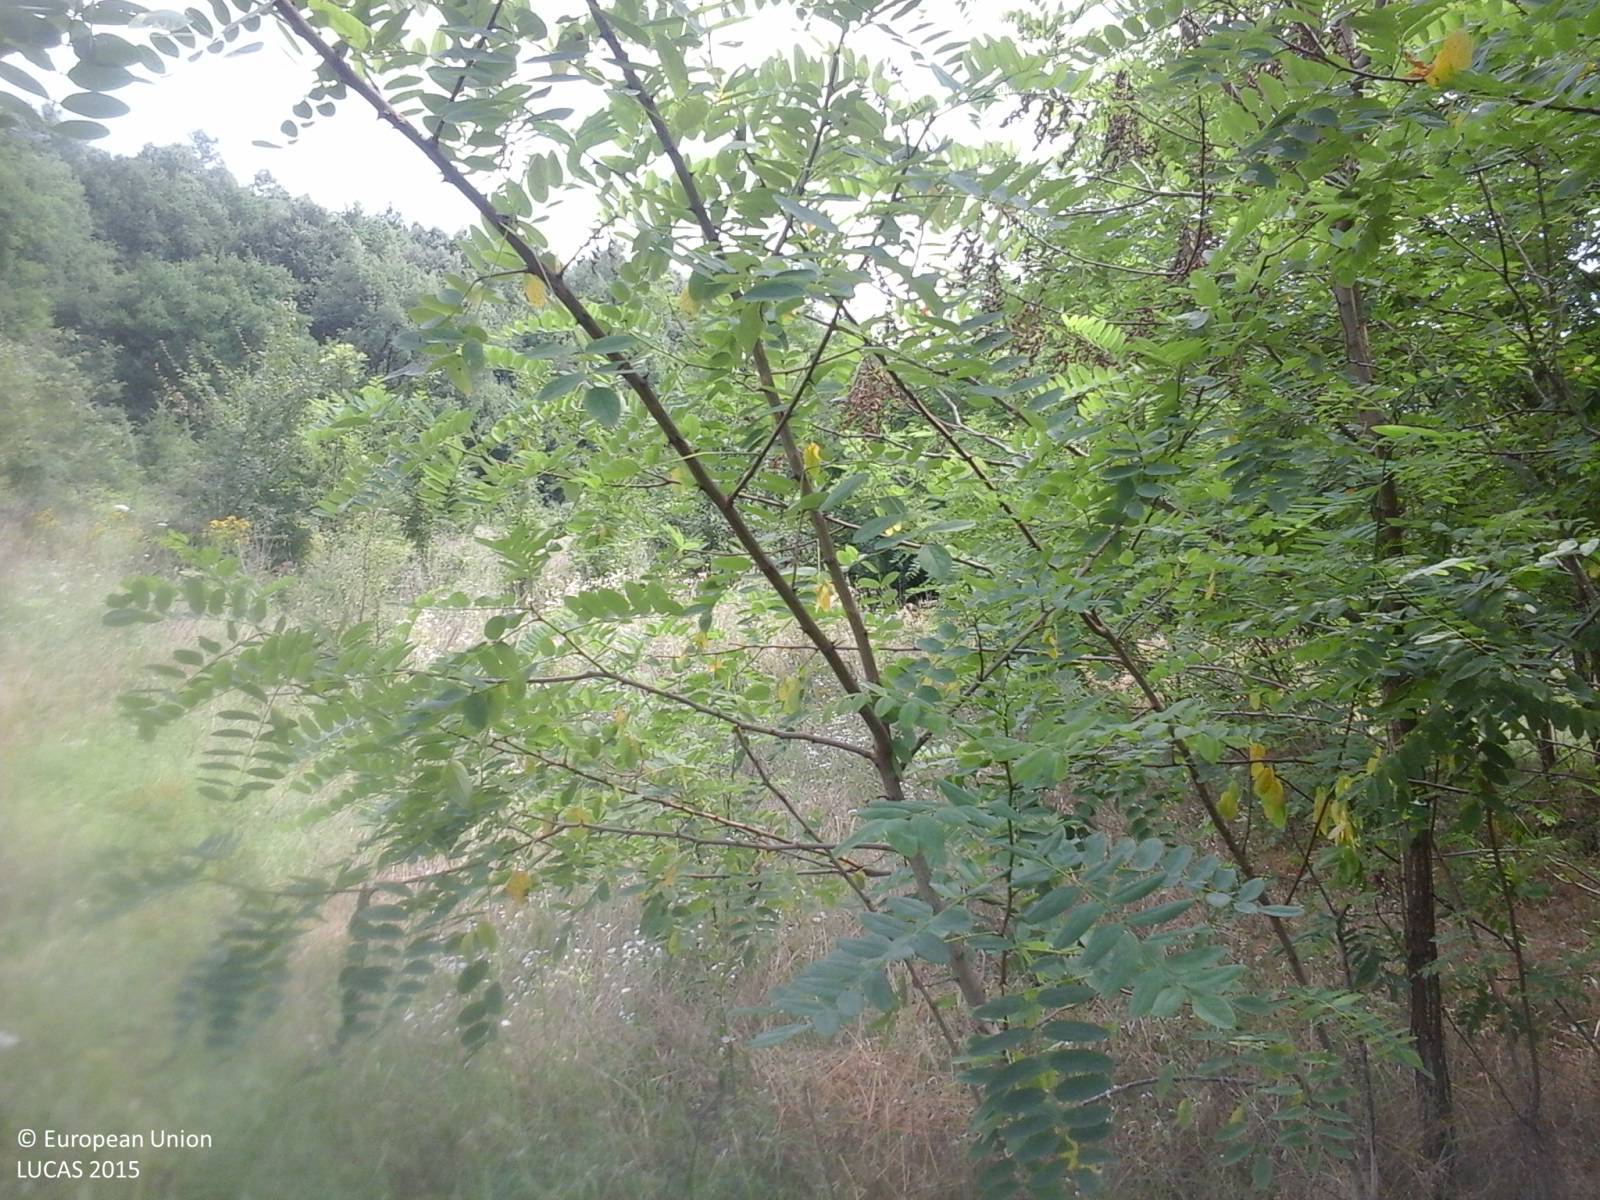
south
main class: Grassland
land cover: Grassland without tree/shrub cover
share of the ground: > 75 %
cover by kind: herbaceous plants 95 %, shrubs 5 %
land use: Semi-natural and natural areas not in use
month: July
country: IT
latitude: 43.0702
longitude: 11.8733
